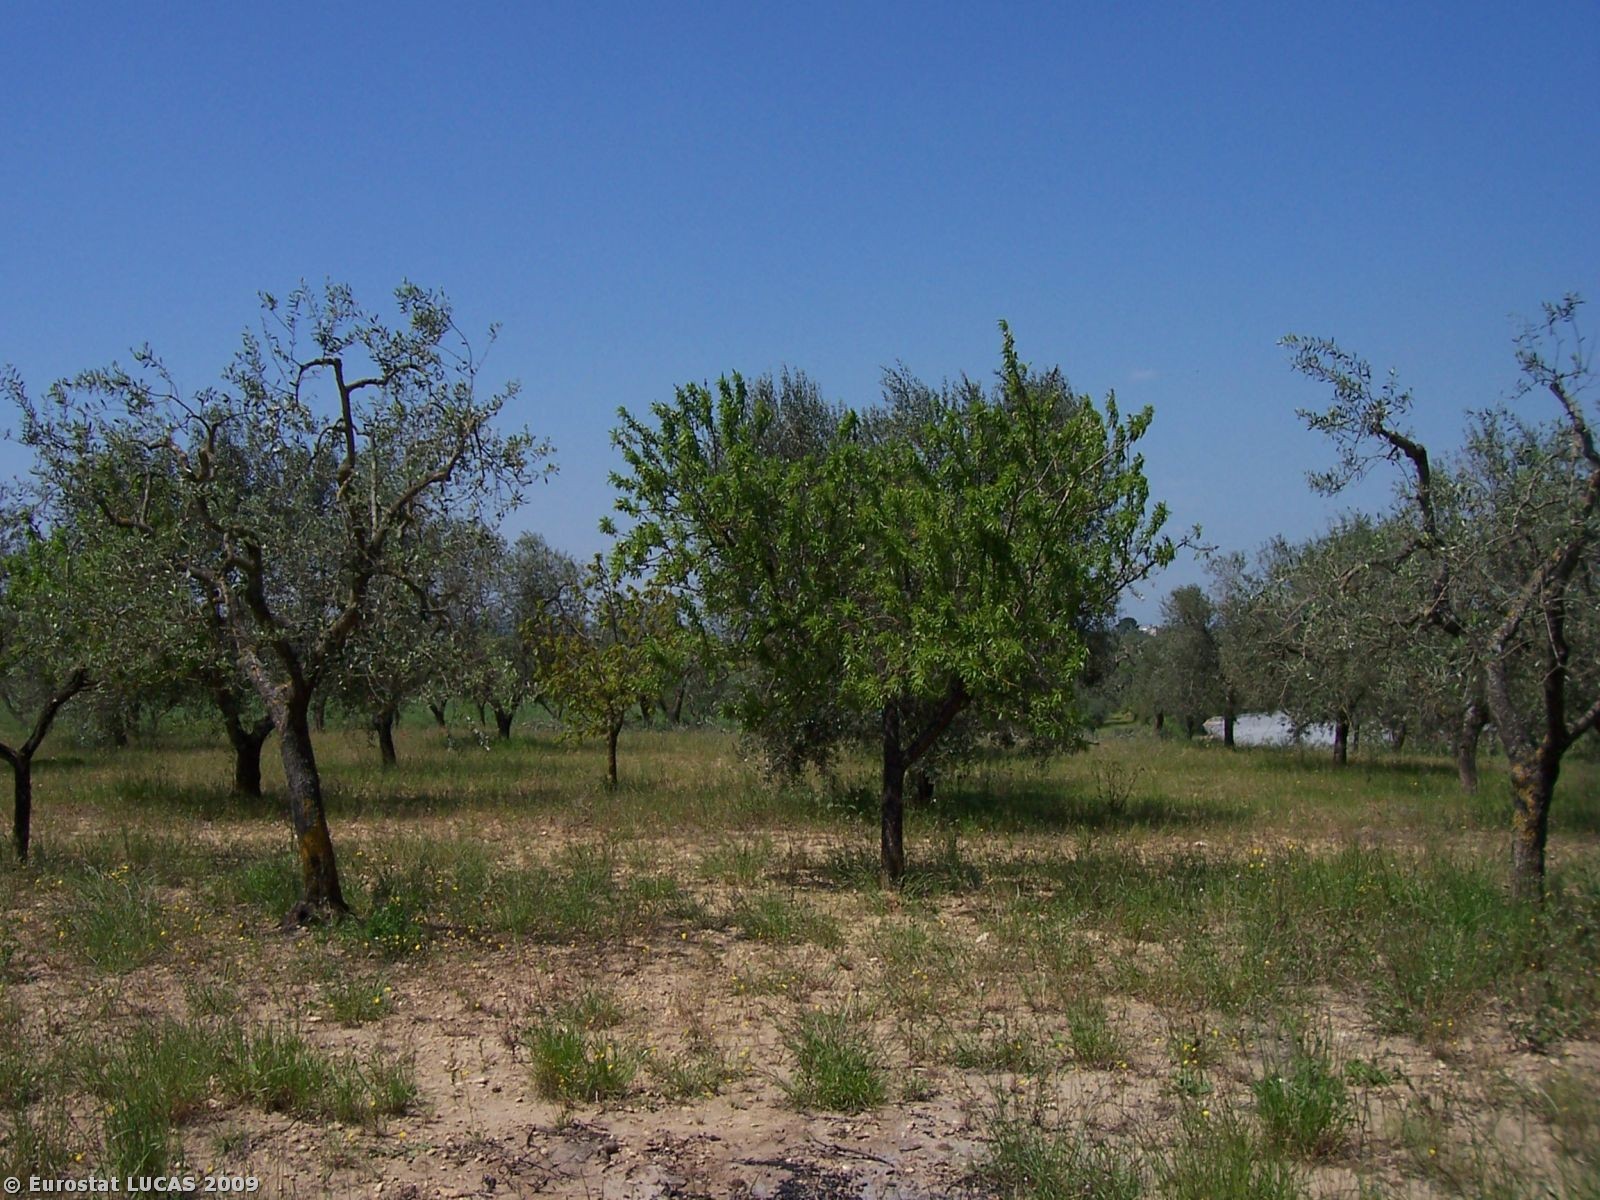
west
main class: Cropland
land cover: Olive groves
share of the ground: 50 - 75 %
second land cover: Spontaneously vegetated surfaces
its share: > 75 %
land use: Agriculture (excluding fallow land and kitchen gardens)
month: May
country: IT
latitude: 40.6566
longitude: 16.9430
